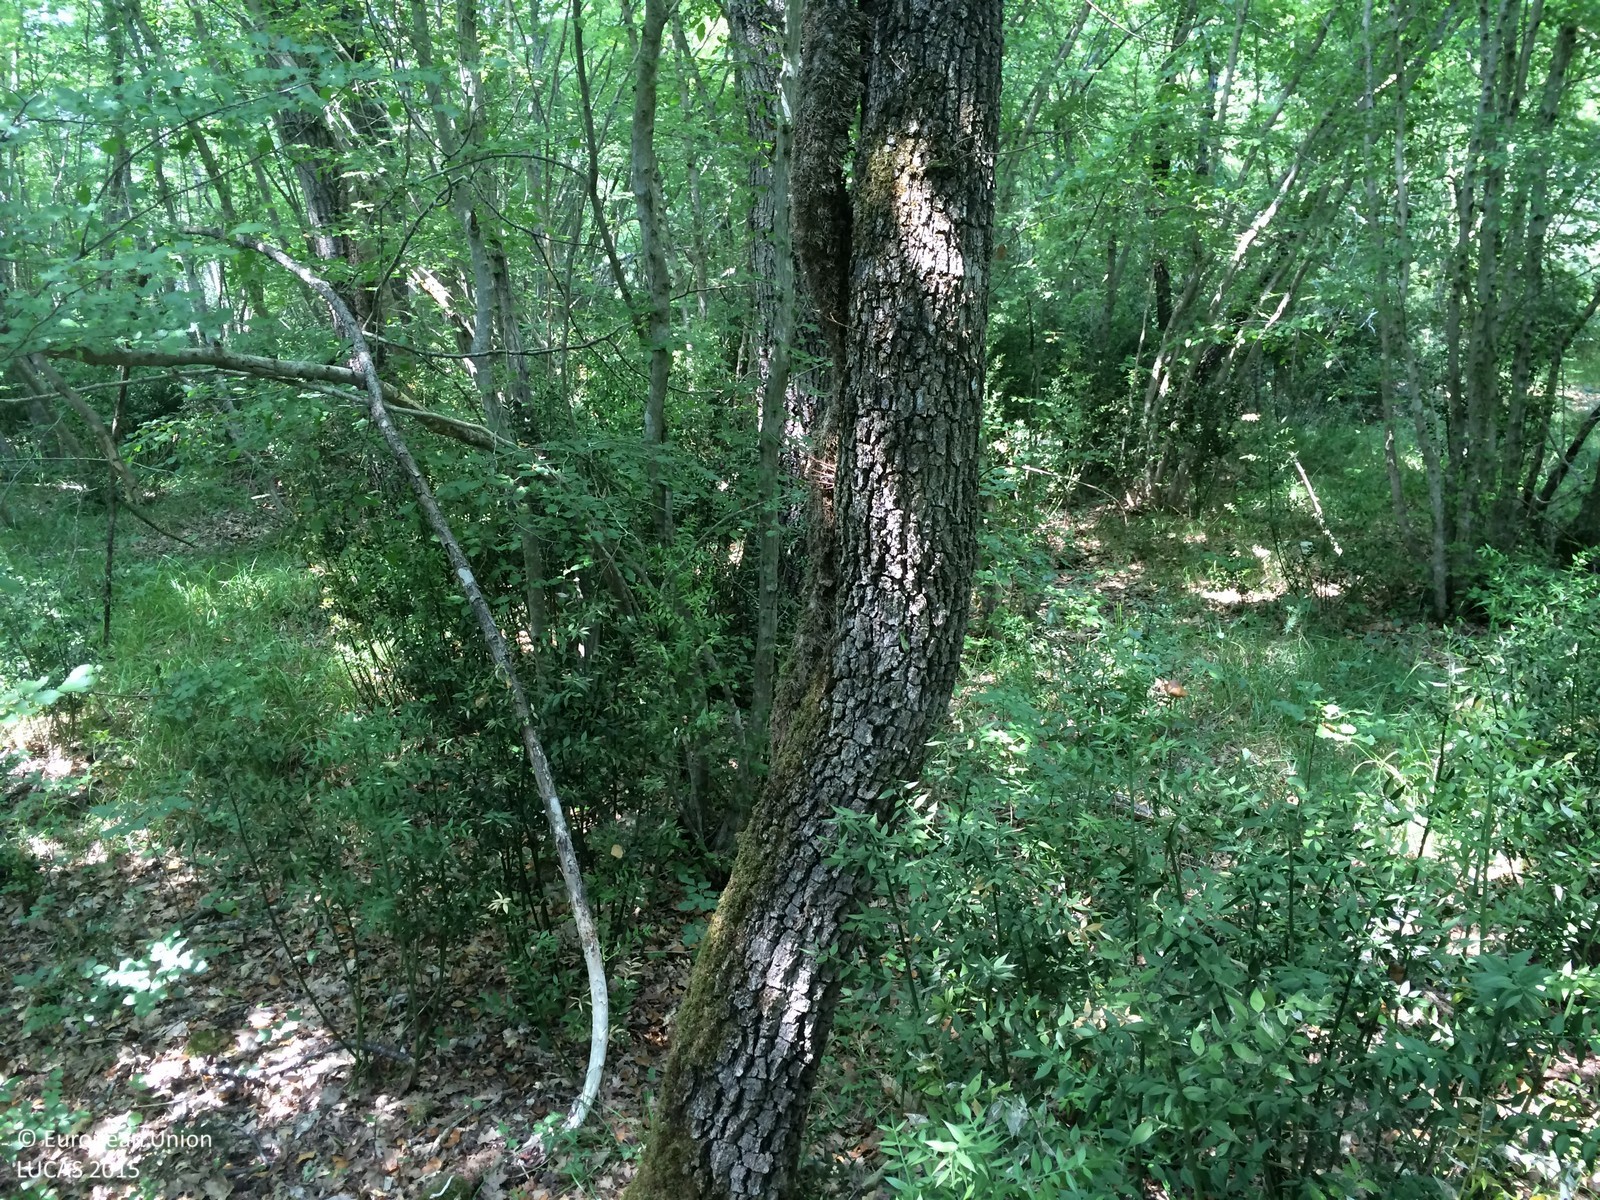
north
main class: Woodland
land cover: Broadleaved woodland
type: beech forest
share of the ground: > 75 %
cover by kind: broadleaved forest trees 90 %, shrubs 10 %
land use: Semi-natural and natural areas not in use
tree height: > 5 m
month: June
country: HR
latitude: 45.1114
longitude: 13.7950
